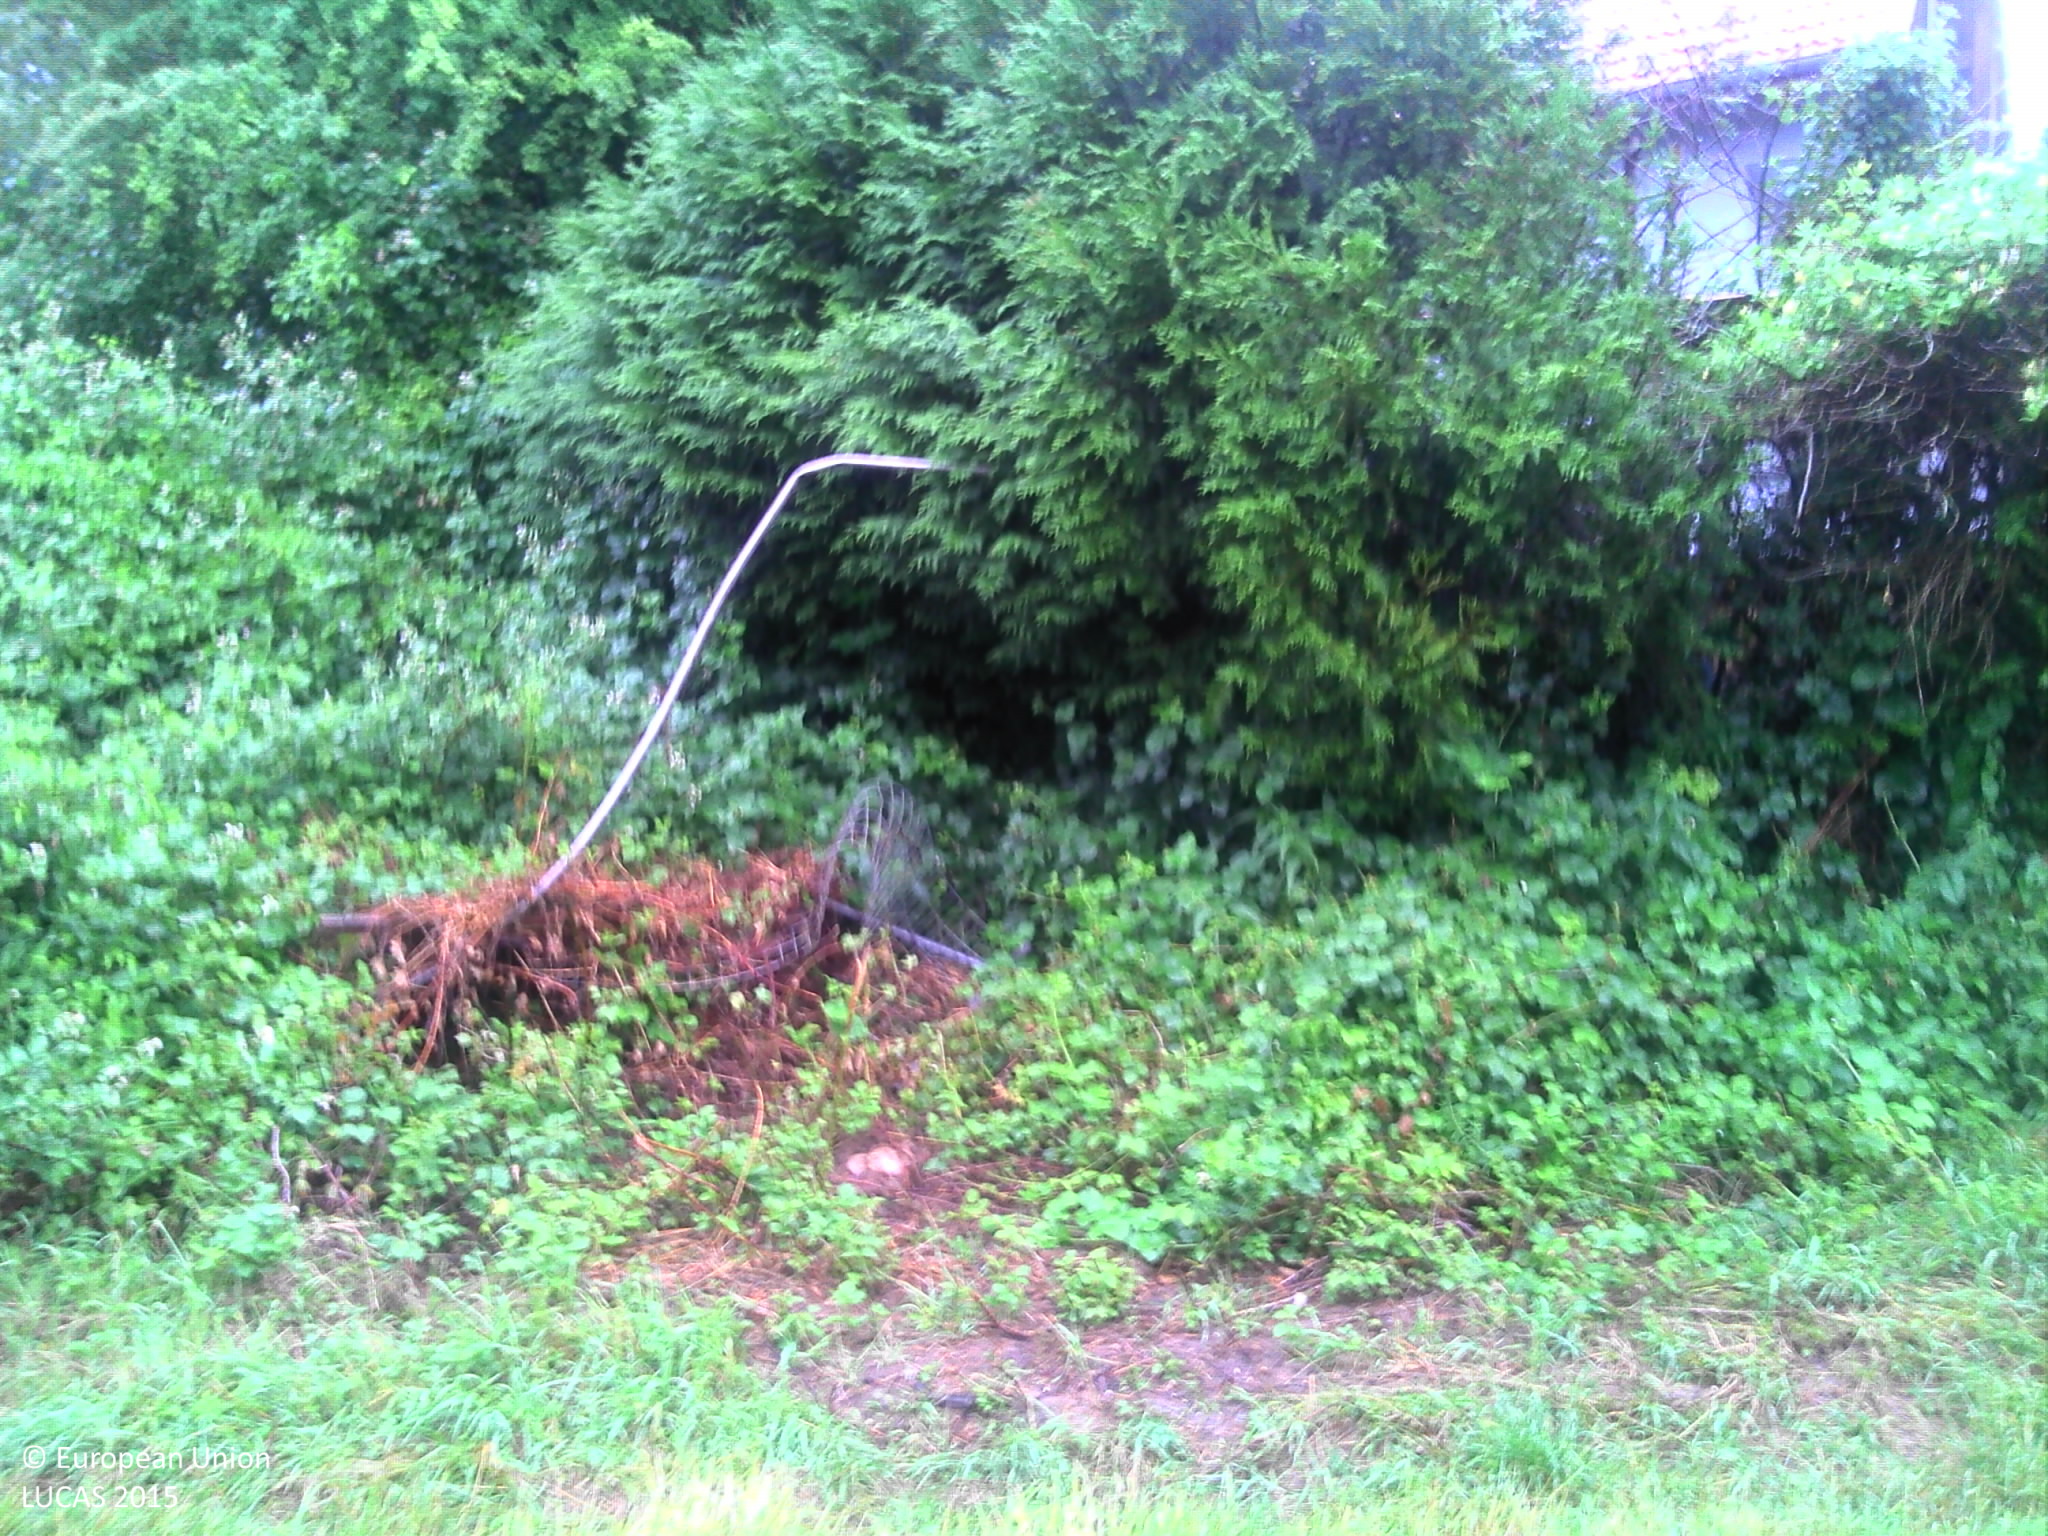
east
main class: Grassland
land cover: Grassland with sparse tree/shrub cover
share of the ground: > 75 %
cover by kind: herbaceous plants 95 %, broadleaved forest trees 5 %
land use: Agriculture (excluding fallow land and kitchen gardens)
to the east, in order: Grassland with sparse tree/shrub cover; Artificial constructions in urban areas; Broadleaved woodland; Artificial constructions in urban areas; Maize
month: June
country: FR
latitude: 47.6522
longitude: 7.3788
